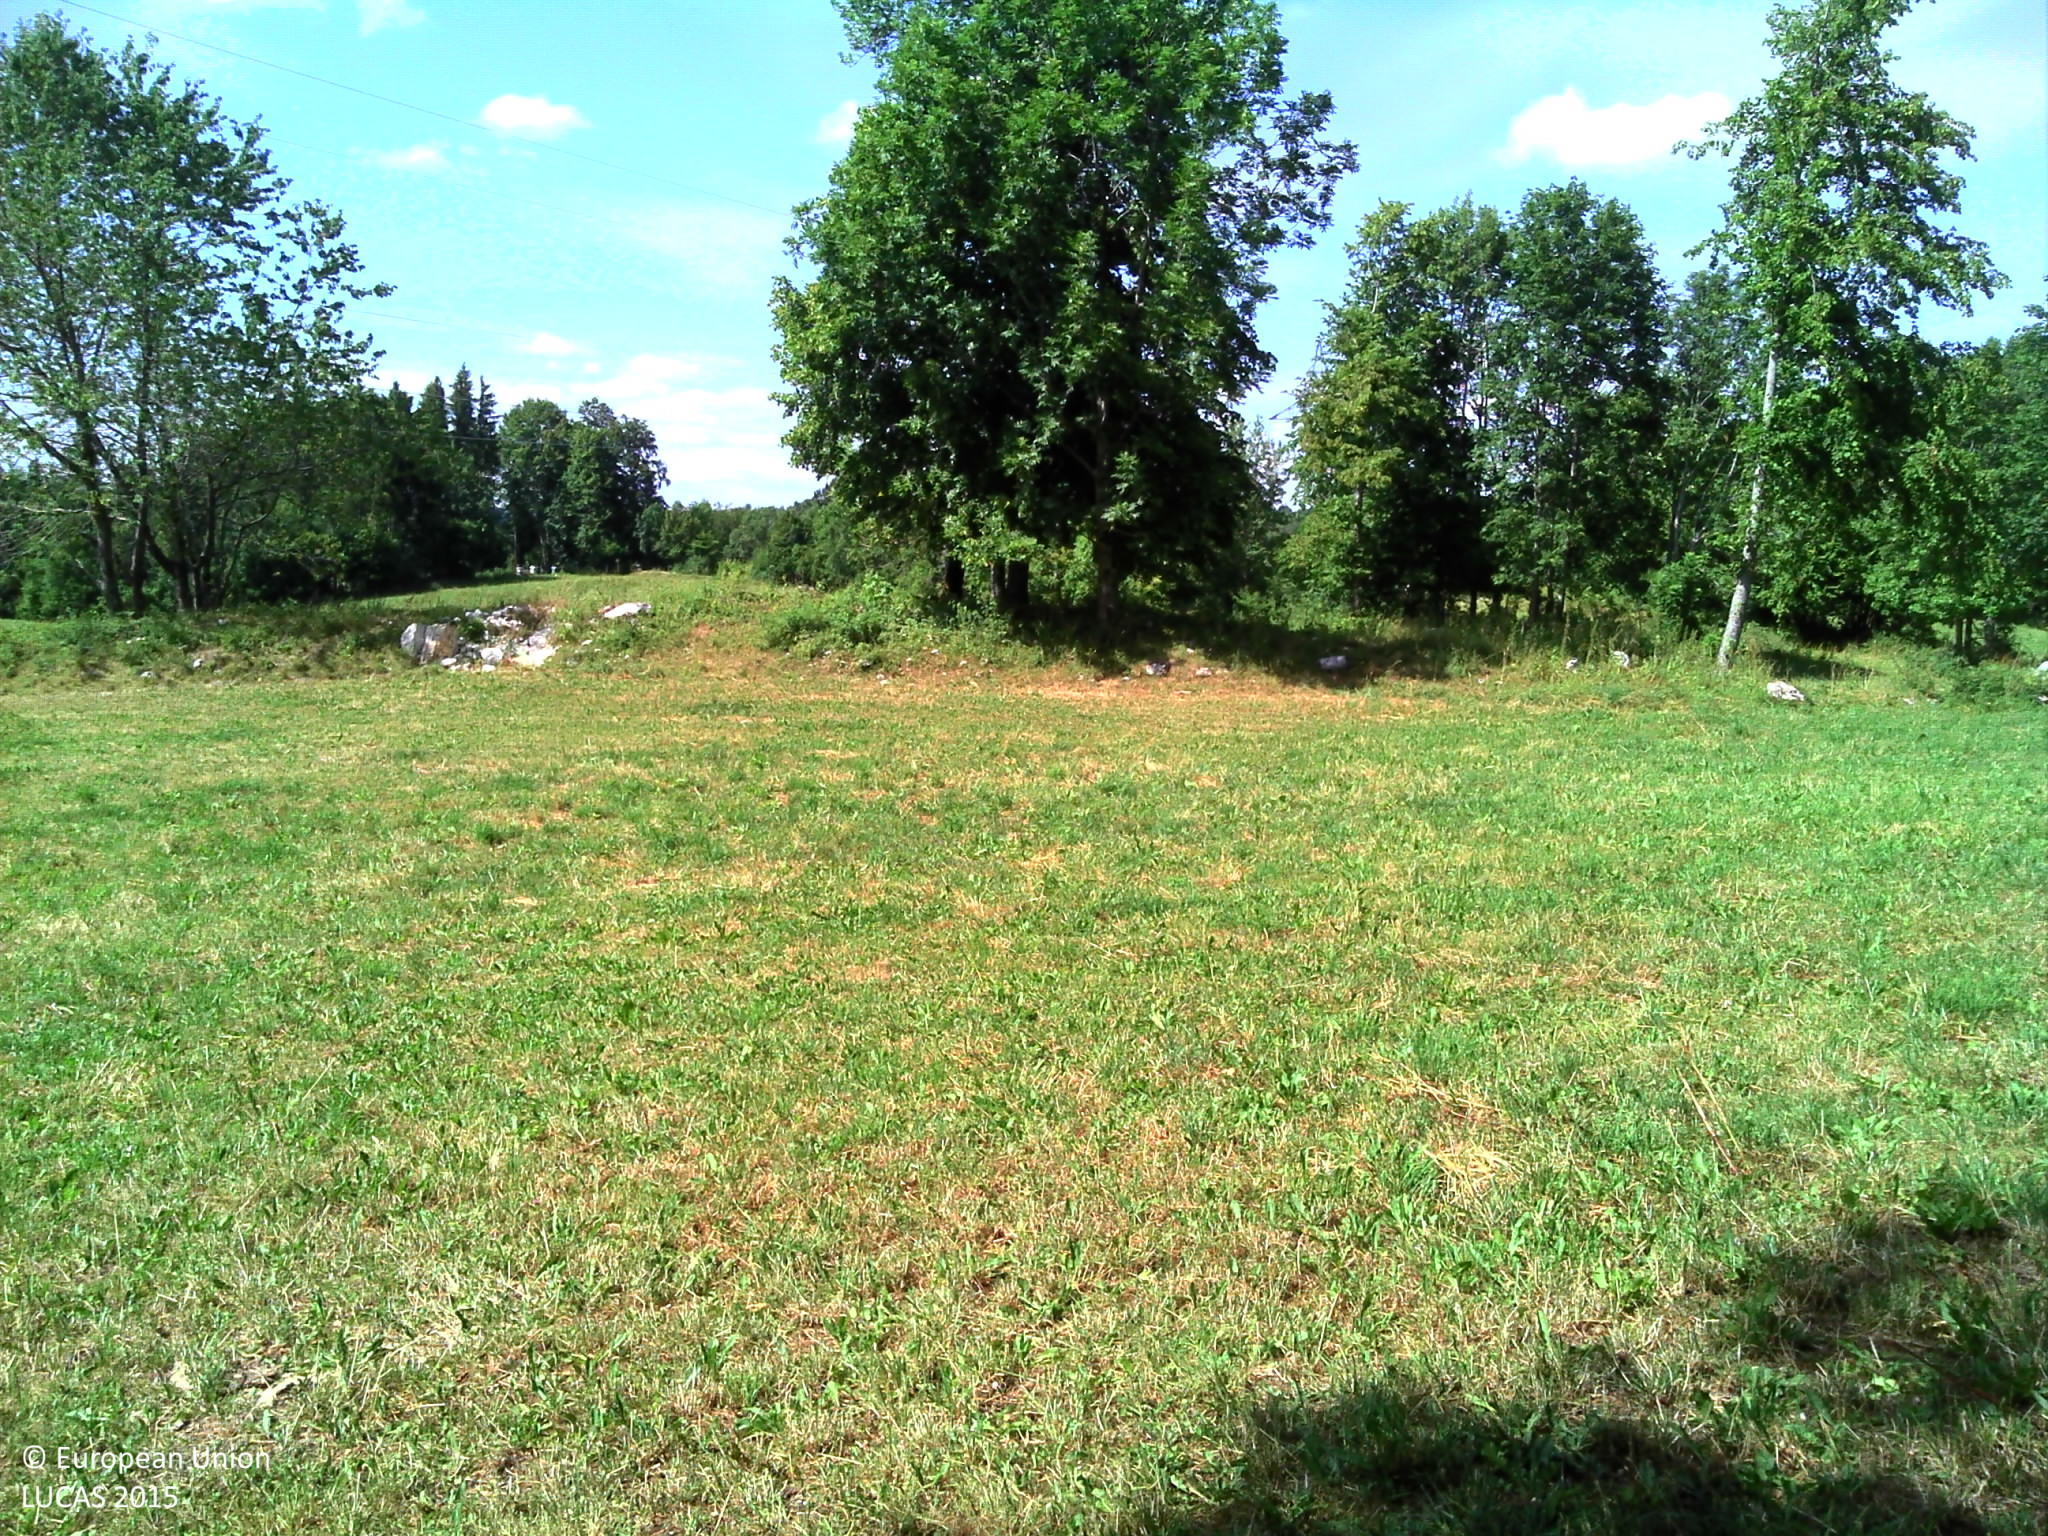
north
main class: Grassland
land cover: Grassland without tree/shrub cover
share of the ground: > 75 %
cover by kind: herbaceous plants 100 %
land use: Agriculture (excluding fallow land and kitchen gardens)
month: July
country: FR
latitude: 46.7655
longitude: 6.0612
